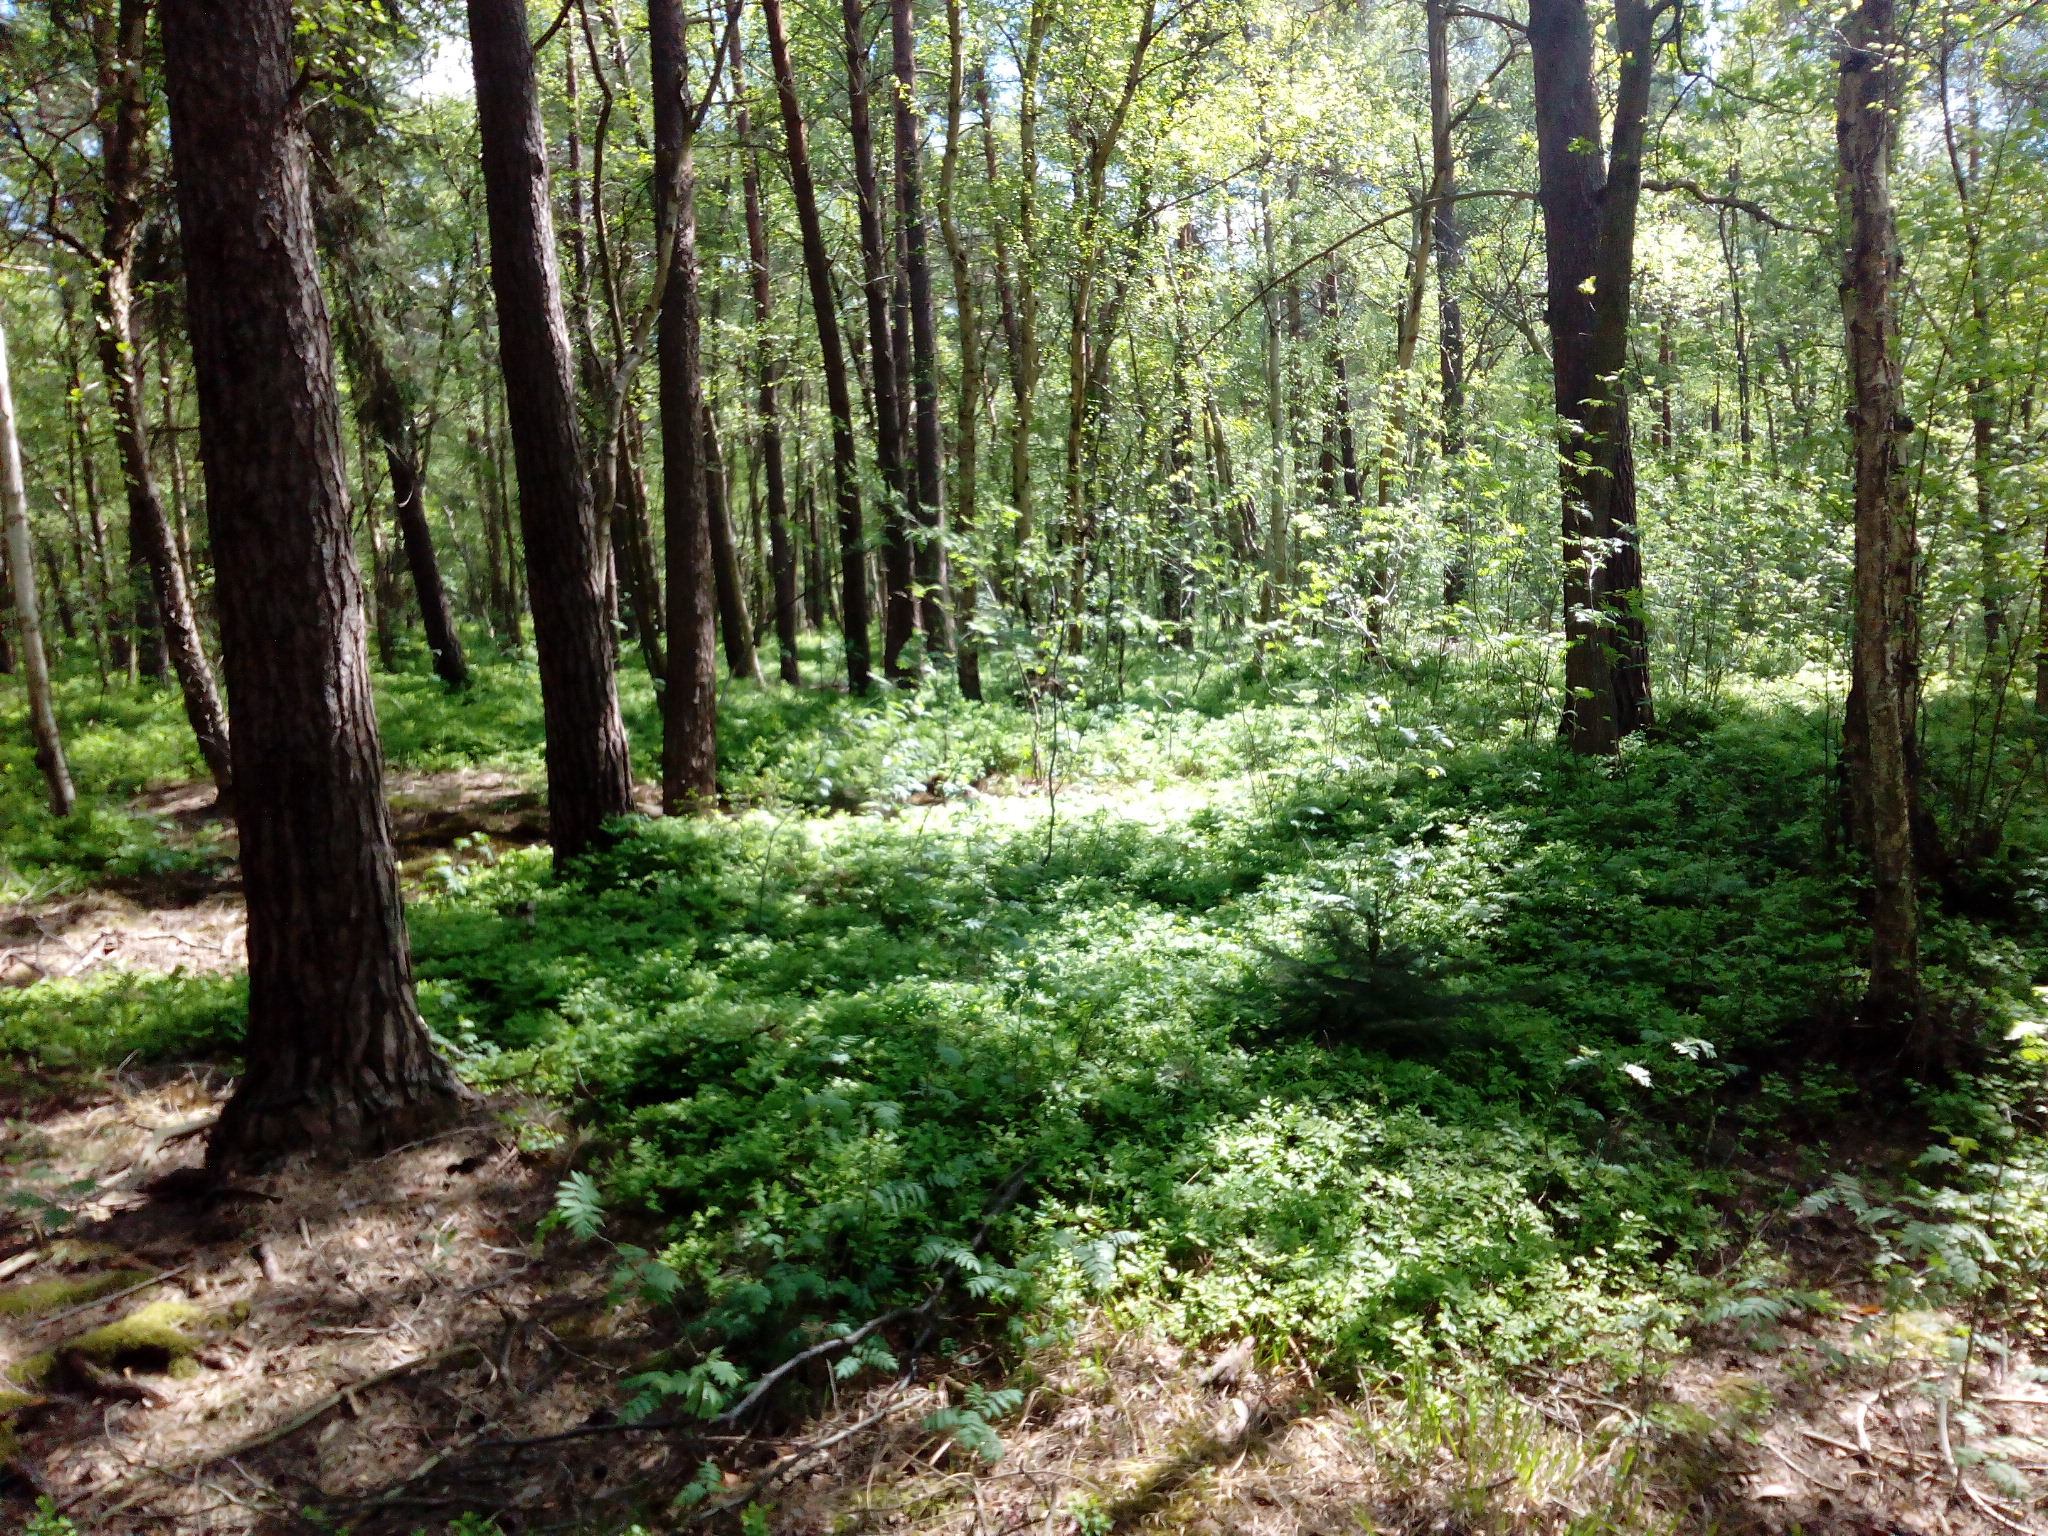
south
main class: Woodland
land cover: Pine dominated mixed woodland
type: hemiboreal forest and nemoral coniferous forest and mixed broadleaved-coniferous forest
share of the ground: > 75 %
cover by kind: coniferous forest trees 60 %, broadleaved forest trees 25 %, herbaceous plants 10 %, unconsolidated bare surface 5 %
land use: Forestry
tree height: > 5 m
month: May
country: DE
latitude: 52.4313
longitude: 9.8971
